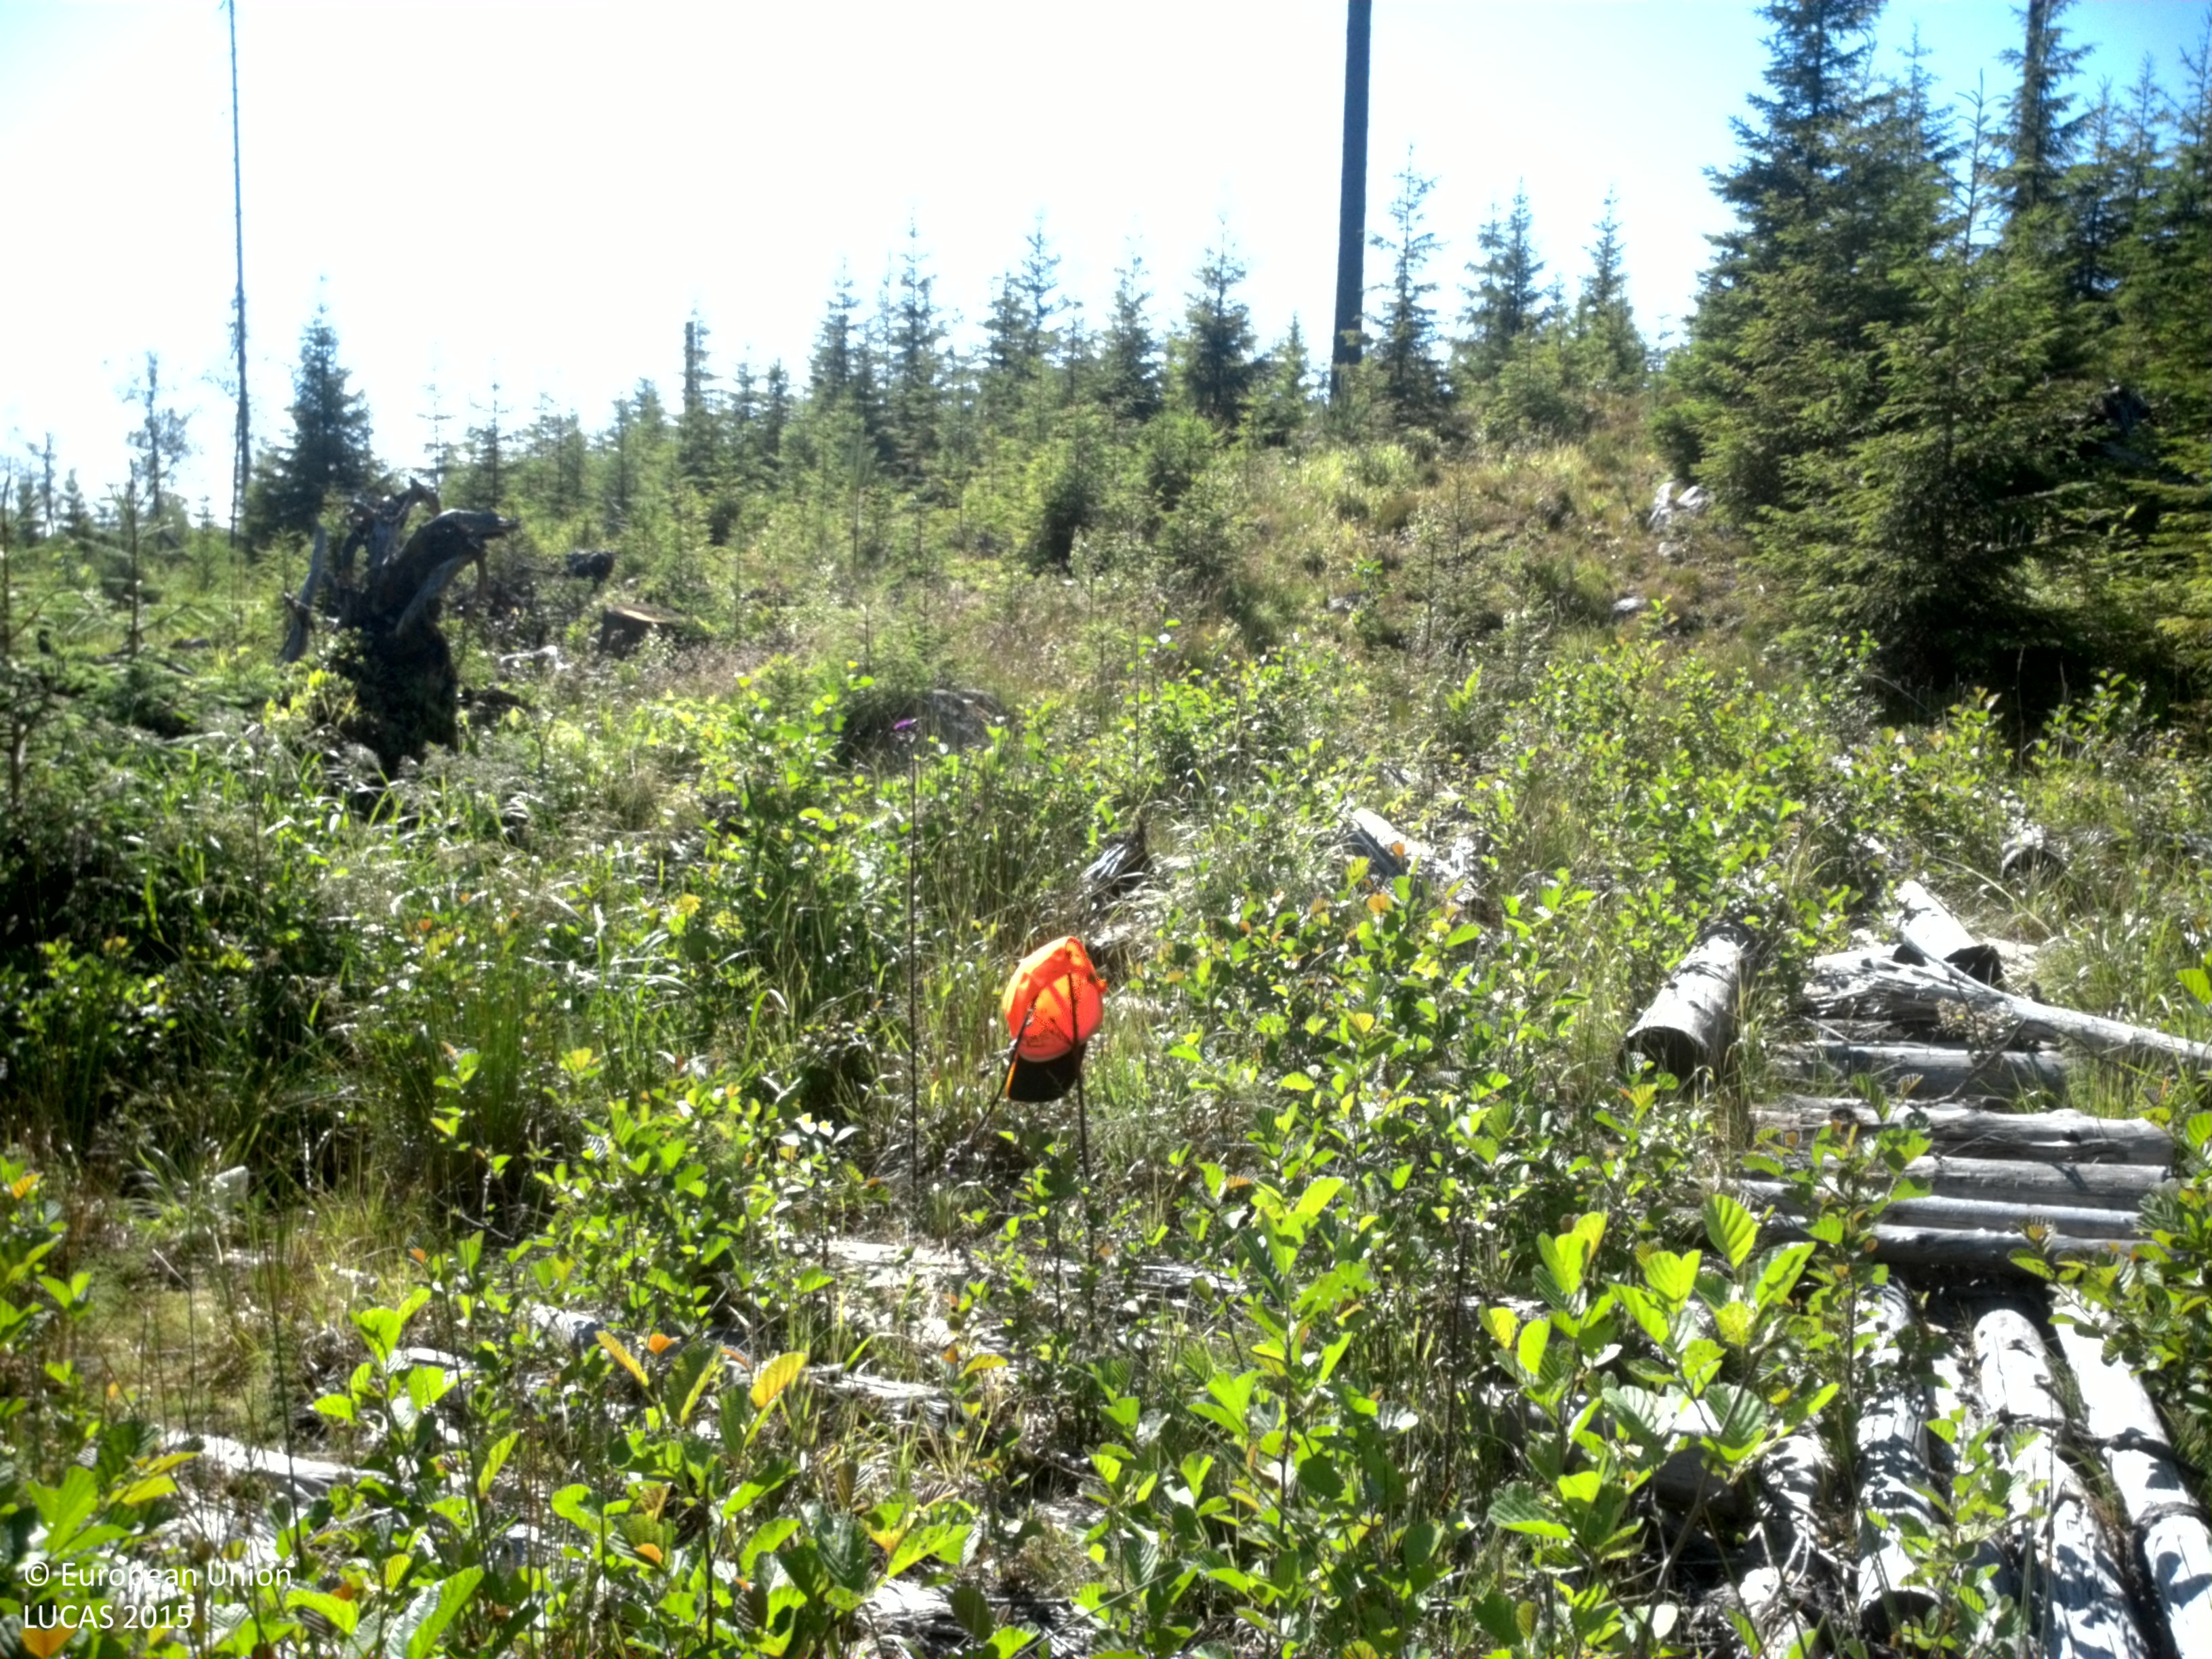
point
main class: Woodland
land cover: Spruce dominated mixed woodland
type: boreal forest
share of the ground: 25 - 50 %
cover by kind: herbaceous plants 30 %, coniferous forest trees 25 %, shrubs 25 %, broadleaved forest trees 20 %
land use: Forestry
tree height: < 5 m
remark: Clear cut
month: July
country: SE
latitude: 59.8231
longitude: 12.0808
